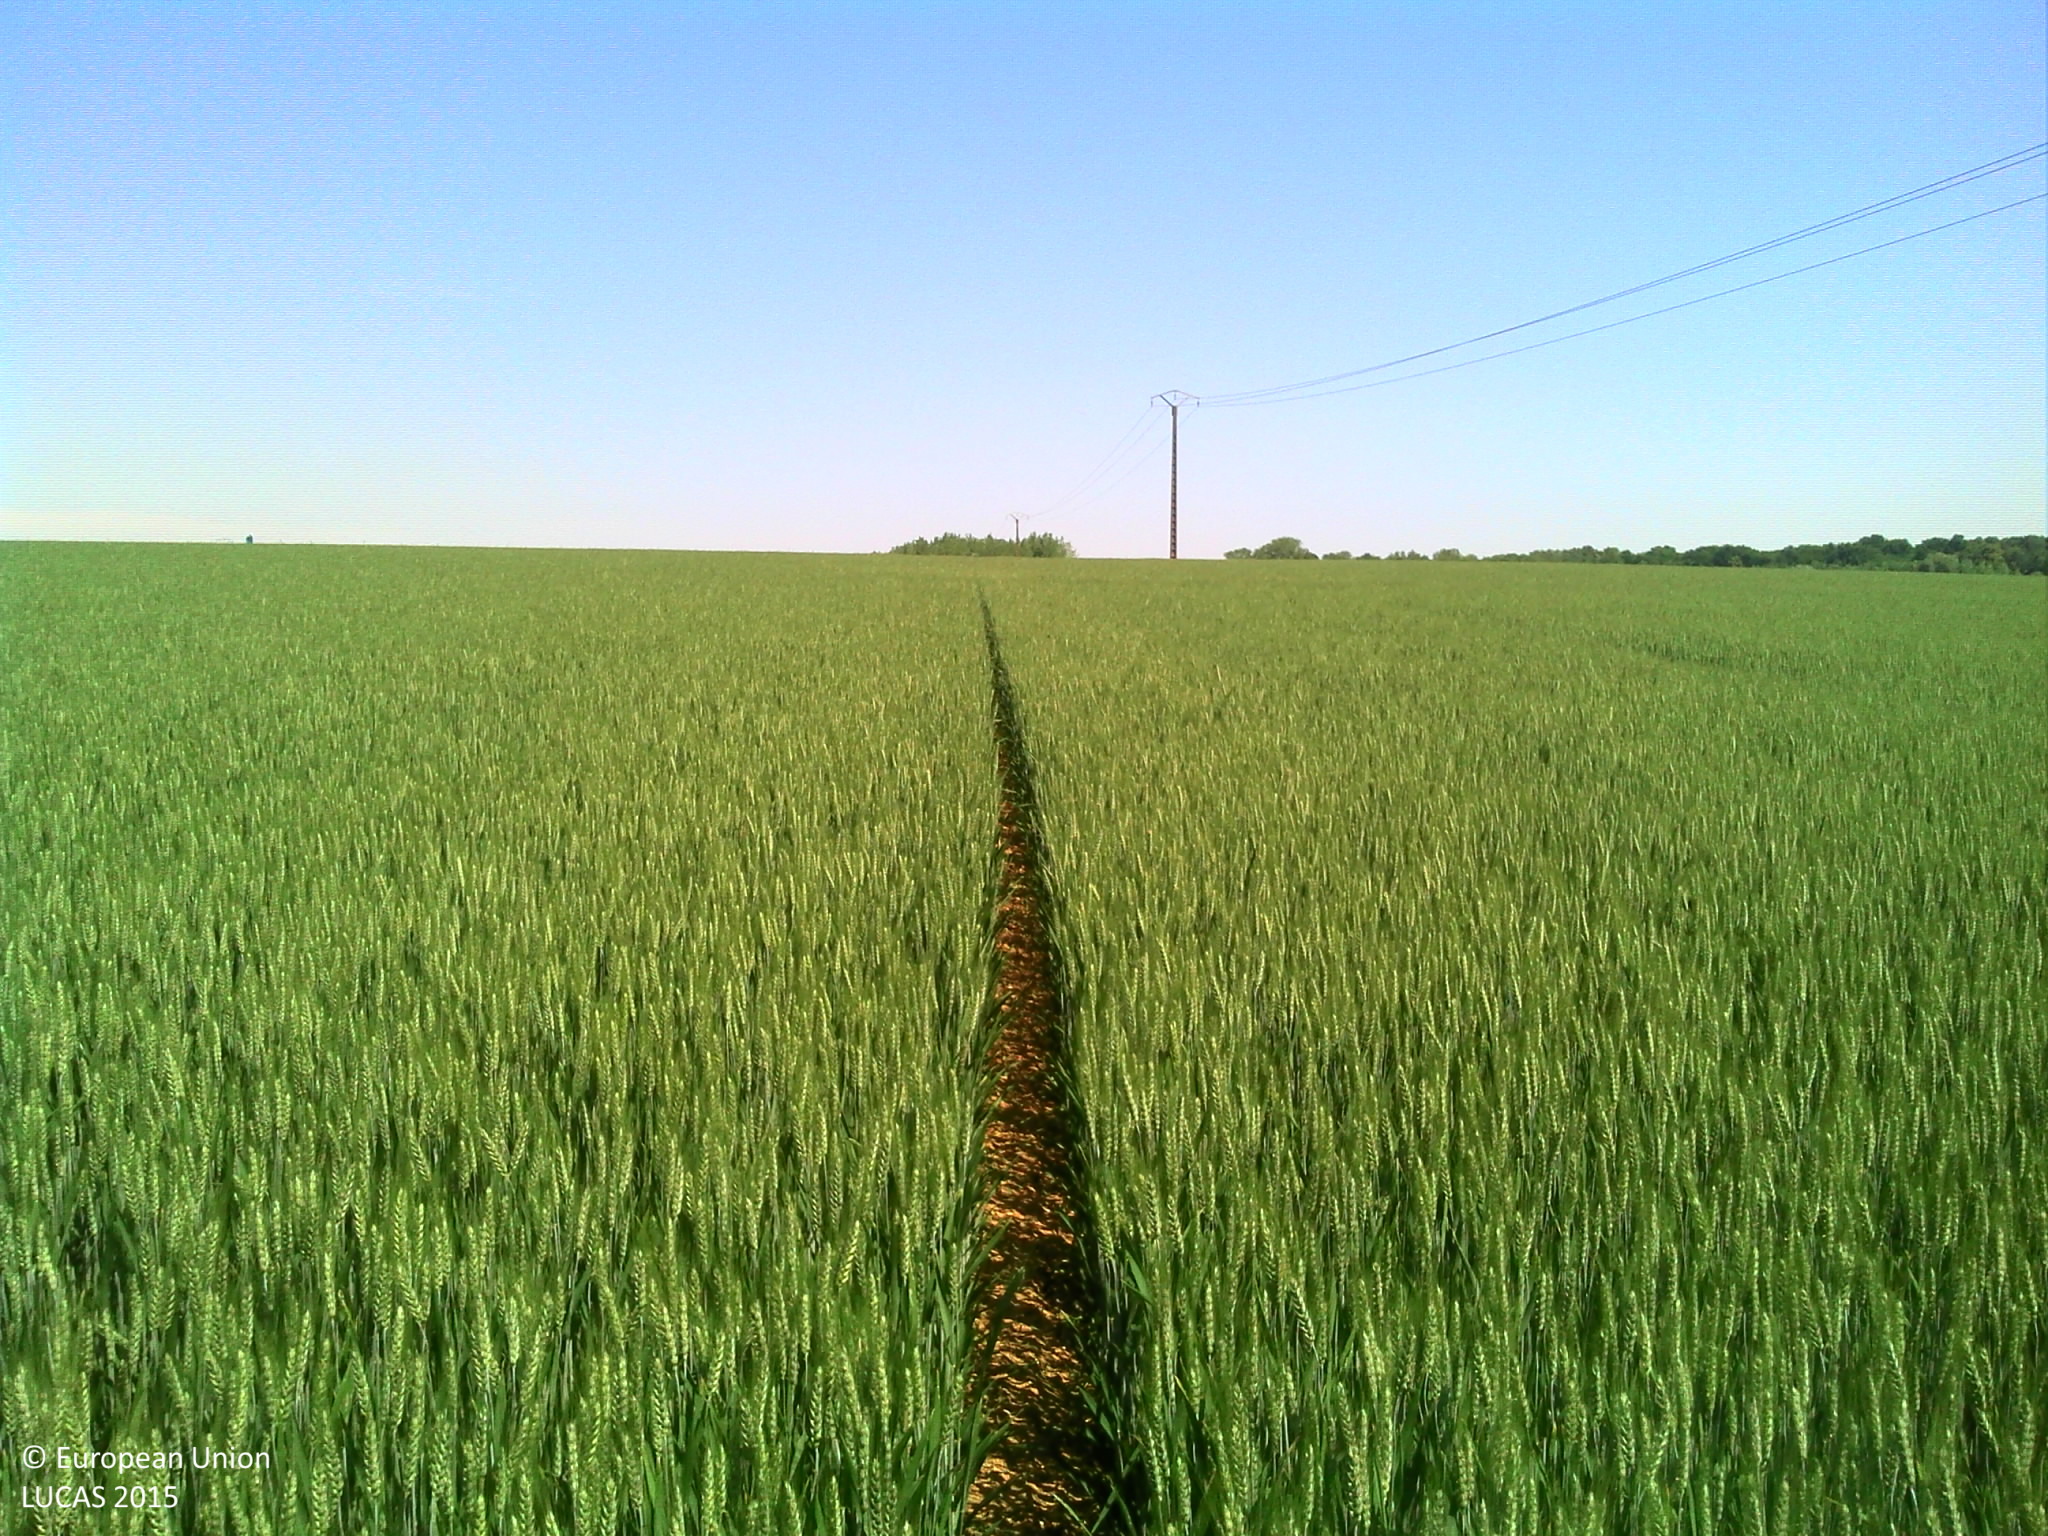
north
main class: Cropland
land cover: Common wheat
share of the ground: > 75 %
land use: Agriculture (excluding fallow land and kitchen gardens)
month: June
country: FR
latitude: 49.5695
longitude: 3.2577
